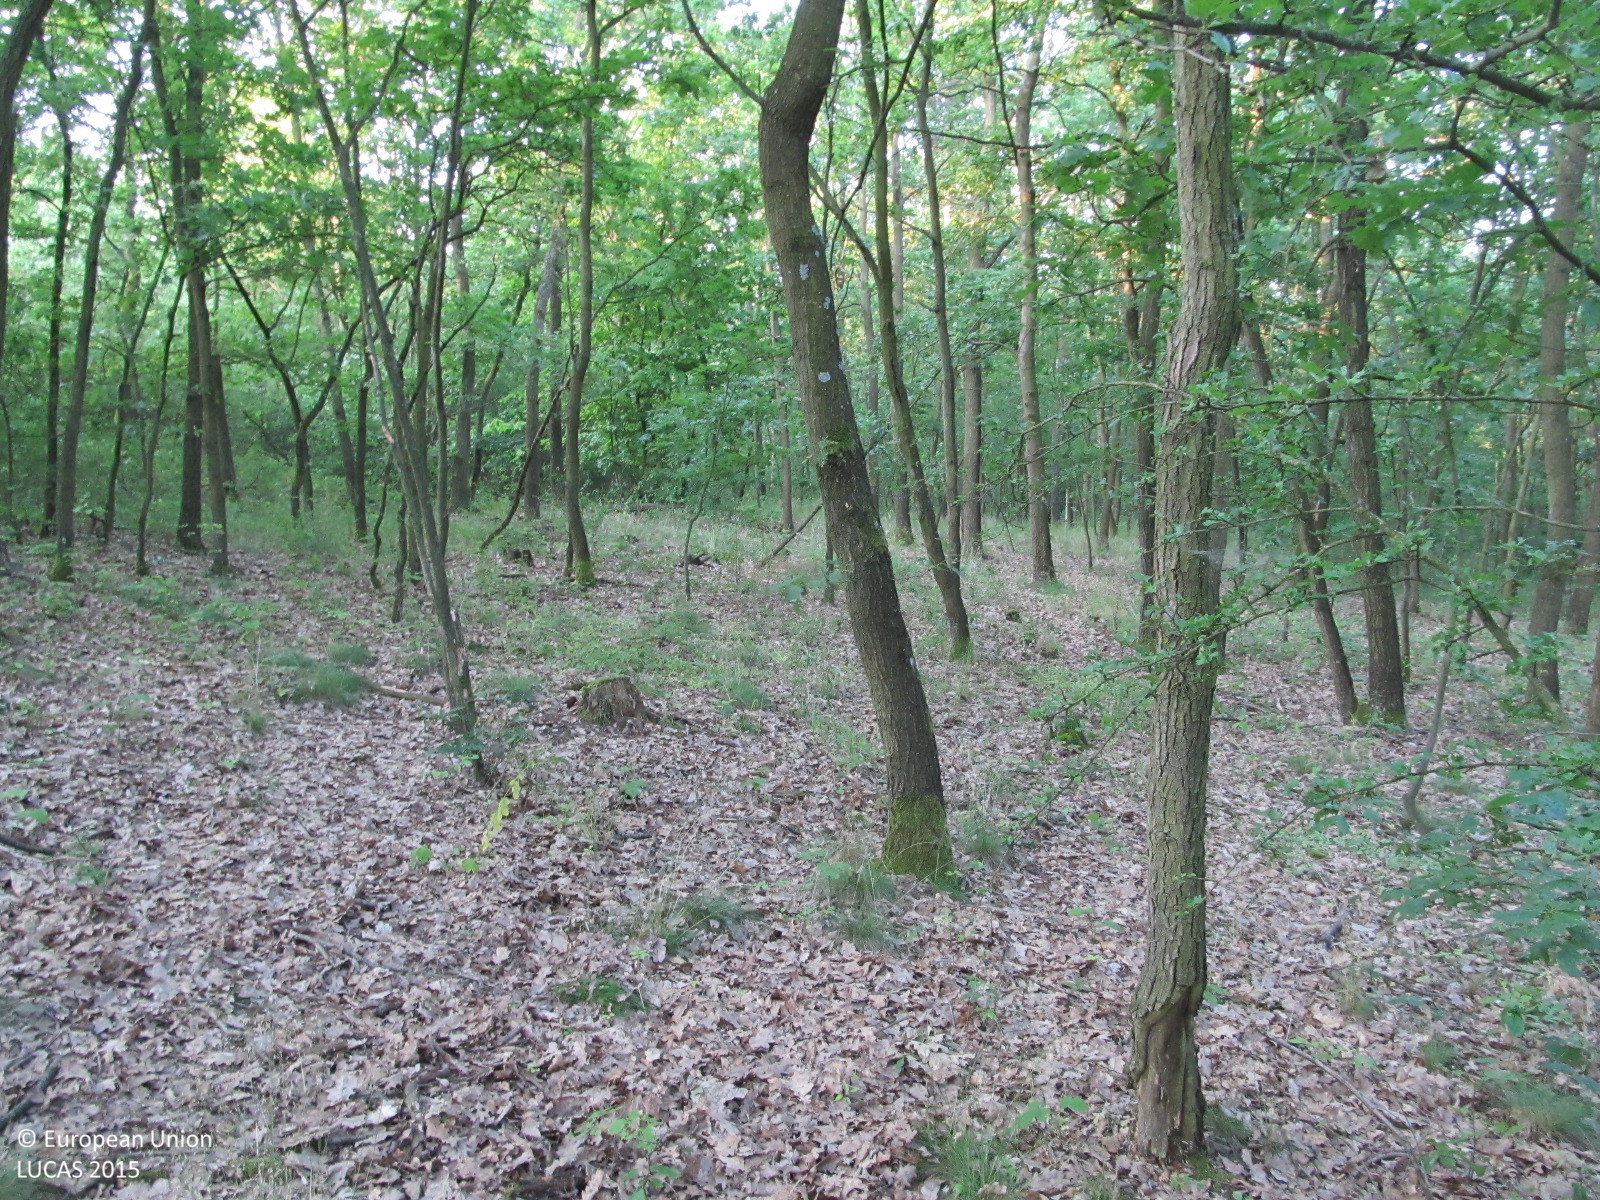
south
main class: Woodland
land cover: Broadleaved woodland
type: mesophytic deciduous forest
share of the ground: > 75 %
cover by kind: broadleaved forest trees 75 %, shrubs 10 %, herbaceous plants 10 %, unconsolidated bare surface 5 %
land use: Forestry
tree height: > 5 m
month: July
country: AT
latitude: 48.7184
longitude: 15.8351
